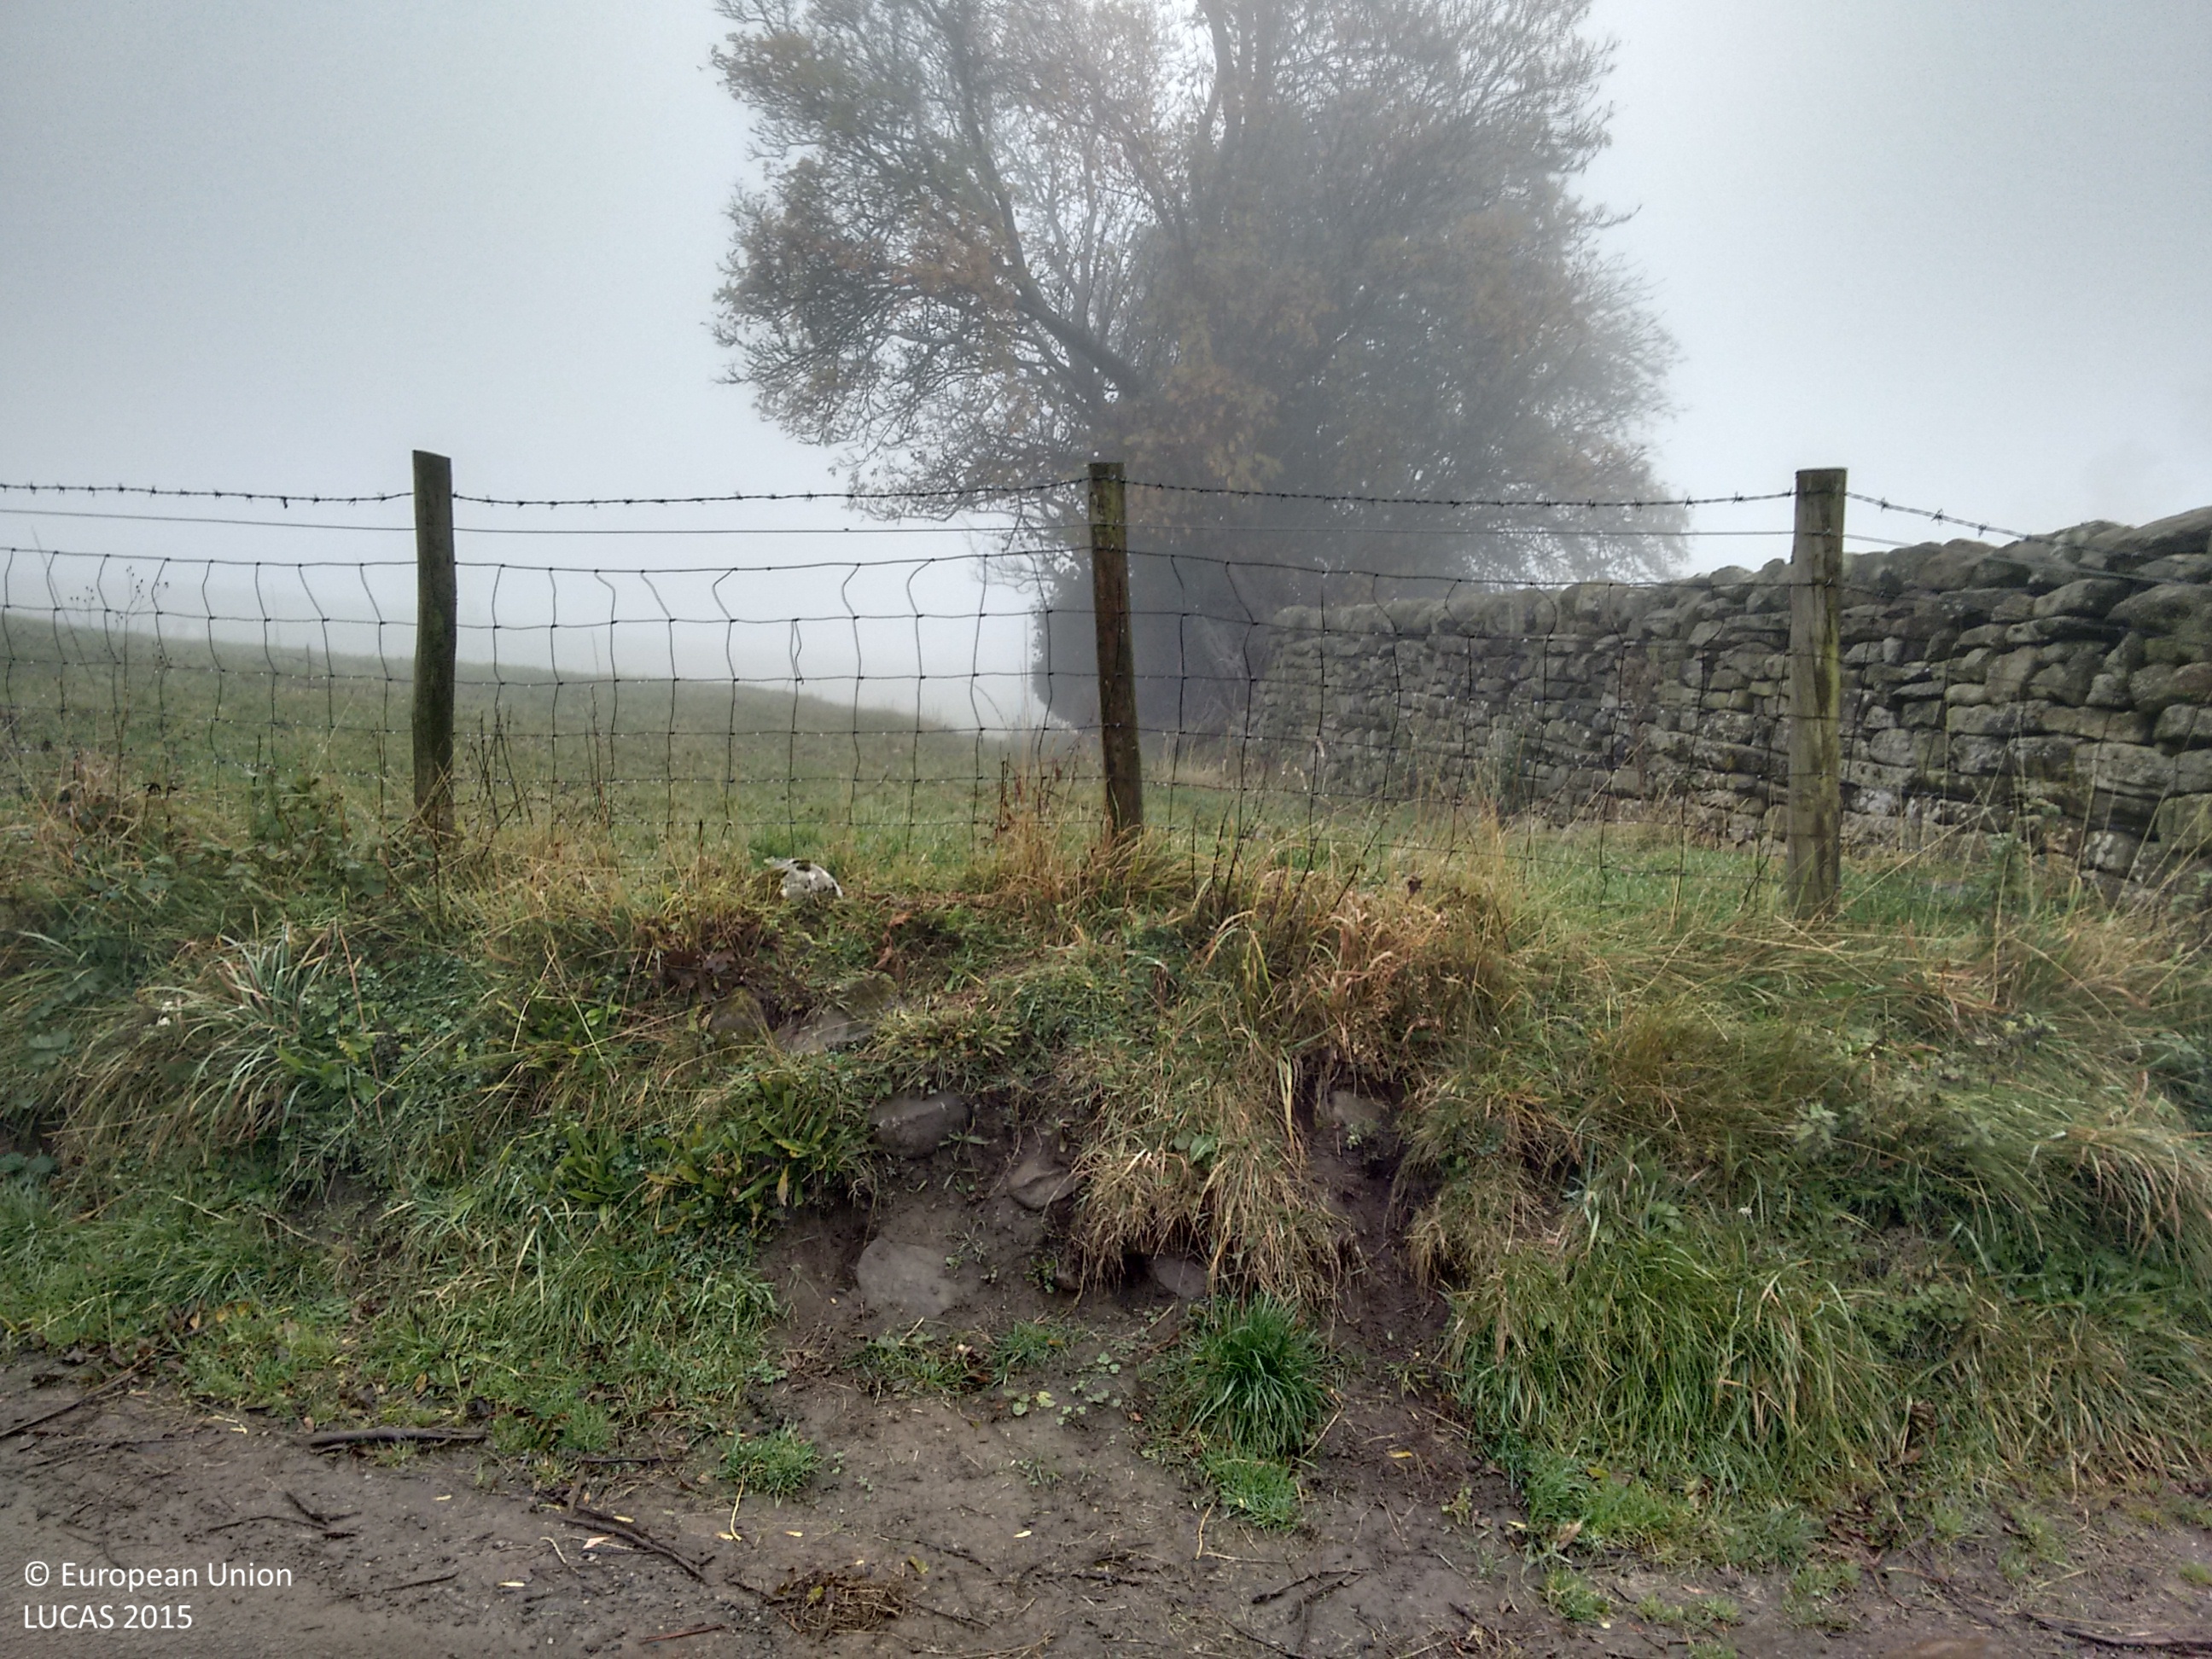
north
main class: Grassland
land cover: Grassland without tree/shrub cover
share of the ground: > 75 %
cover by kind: herbaceous plants 100 %
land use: Agriculture (excluding fallow land and kitchen gardens)
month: October
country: GB
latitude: 54.4803
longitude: -1.9547
